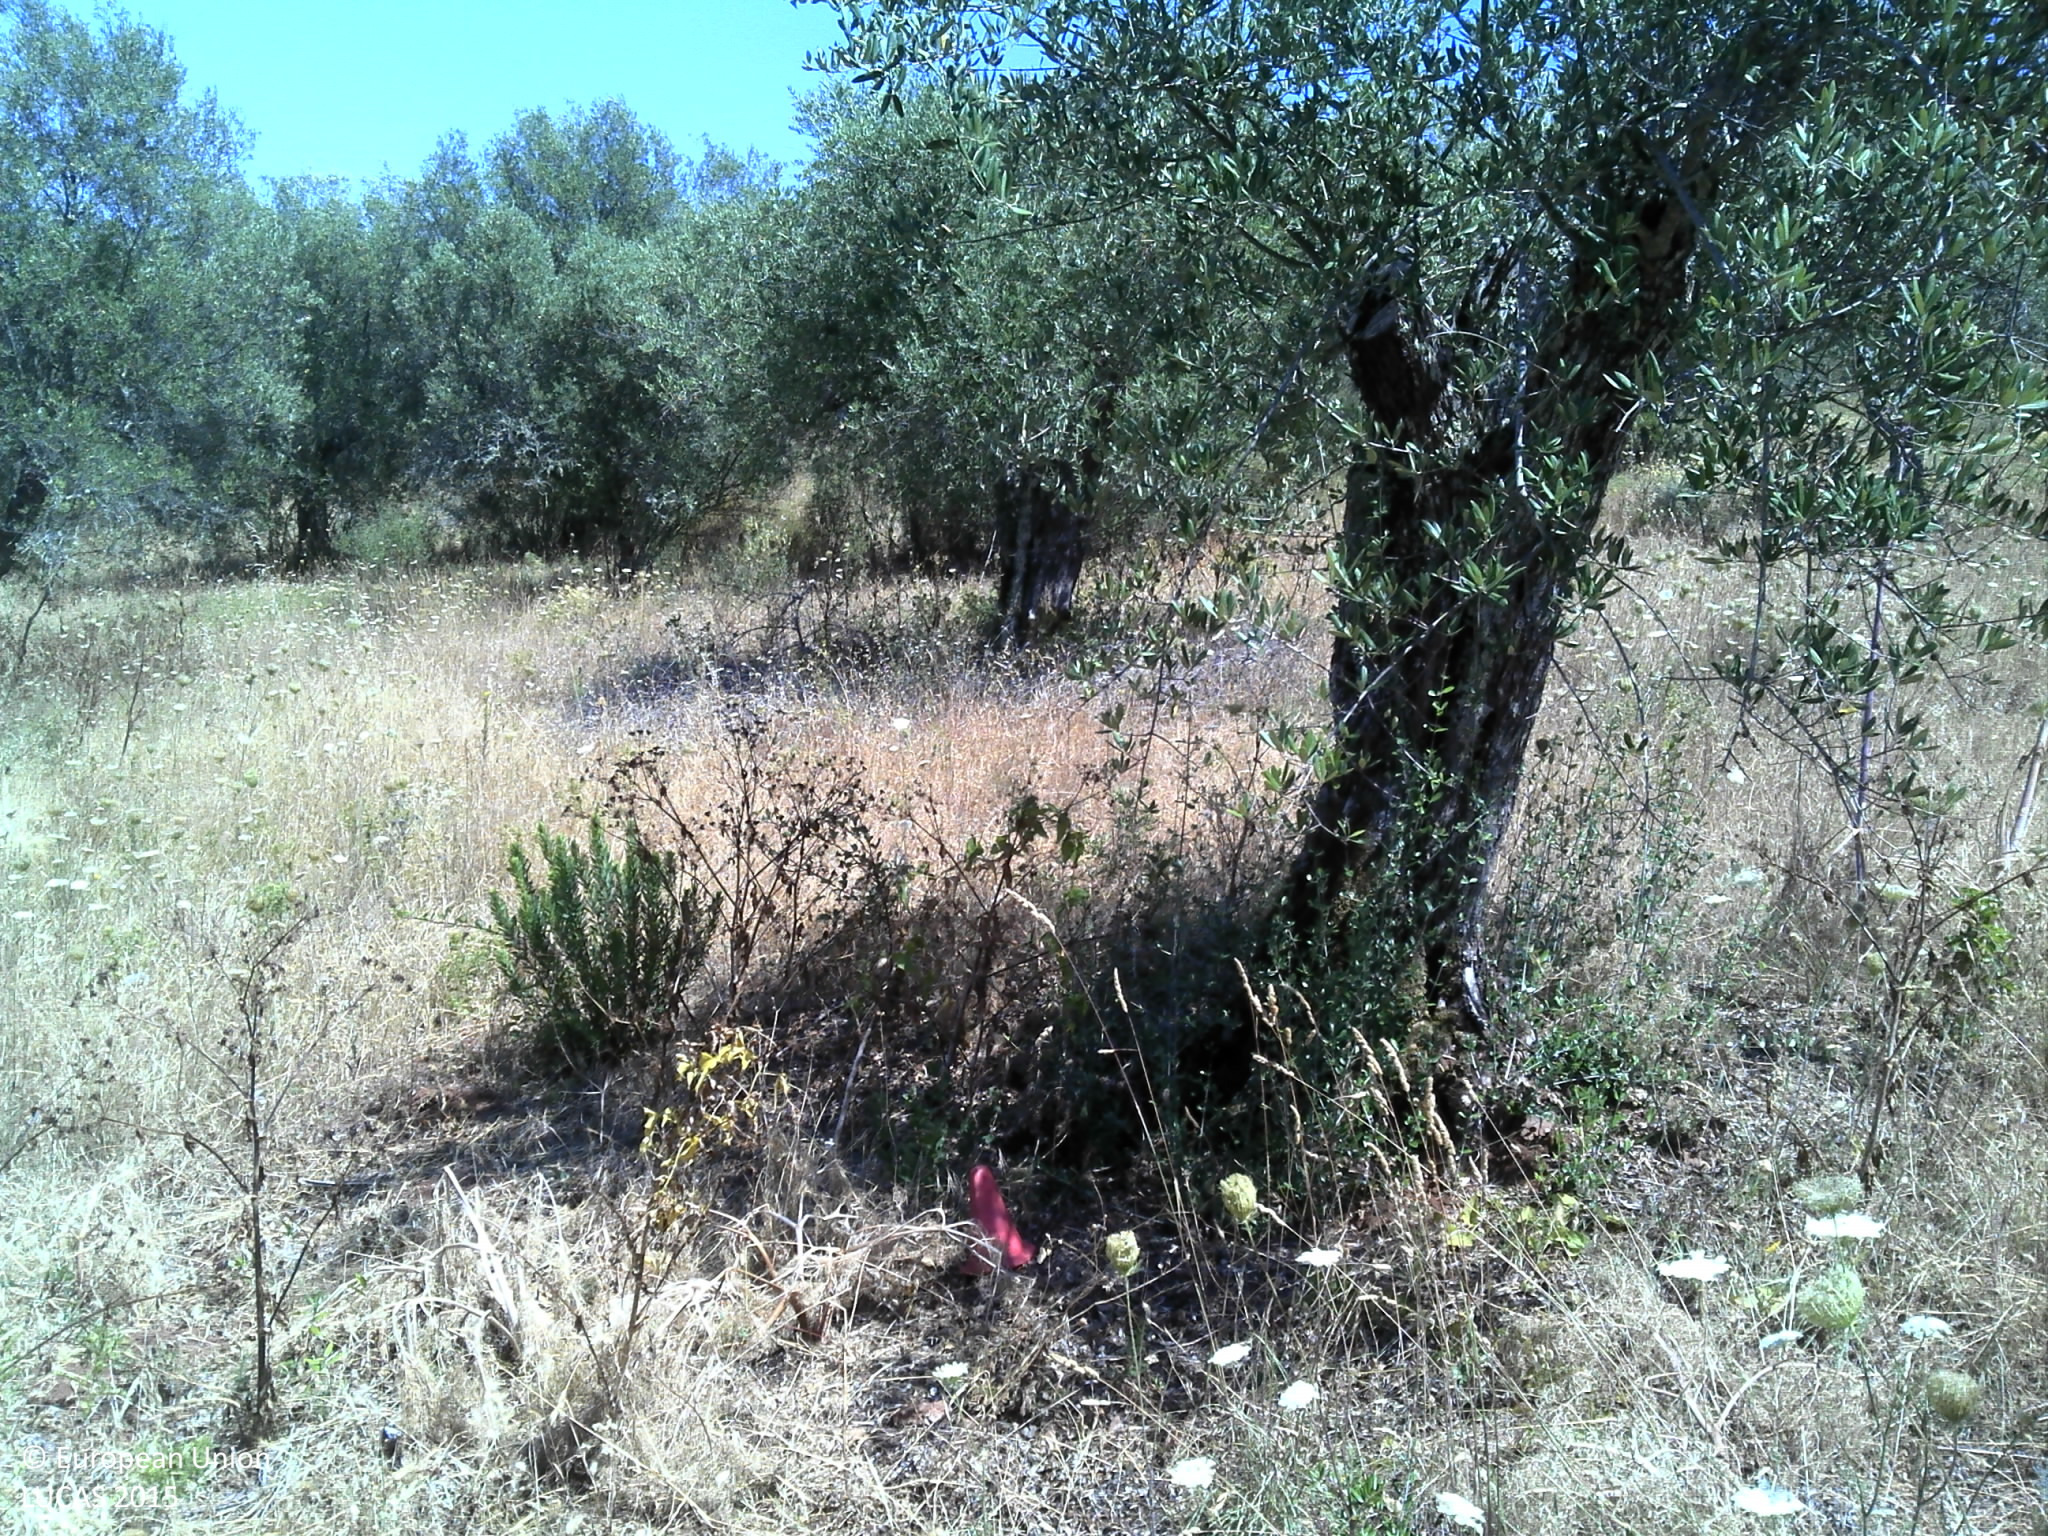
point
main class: Cropland
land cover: Olive groves
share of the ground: 50 - 75 %
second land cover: Grassland without tree/shrub cover
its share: 25 - 50 %
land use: Abandoned areas
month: June
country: PT
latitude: 37.9637
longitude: -7.2807
